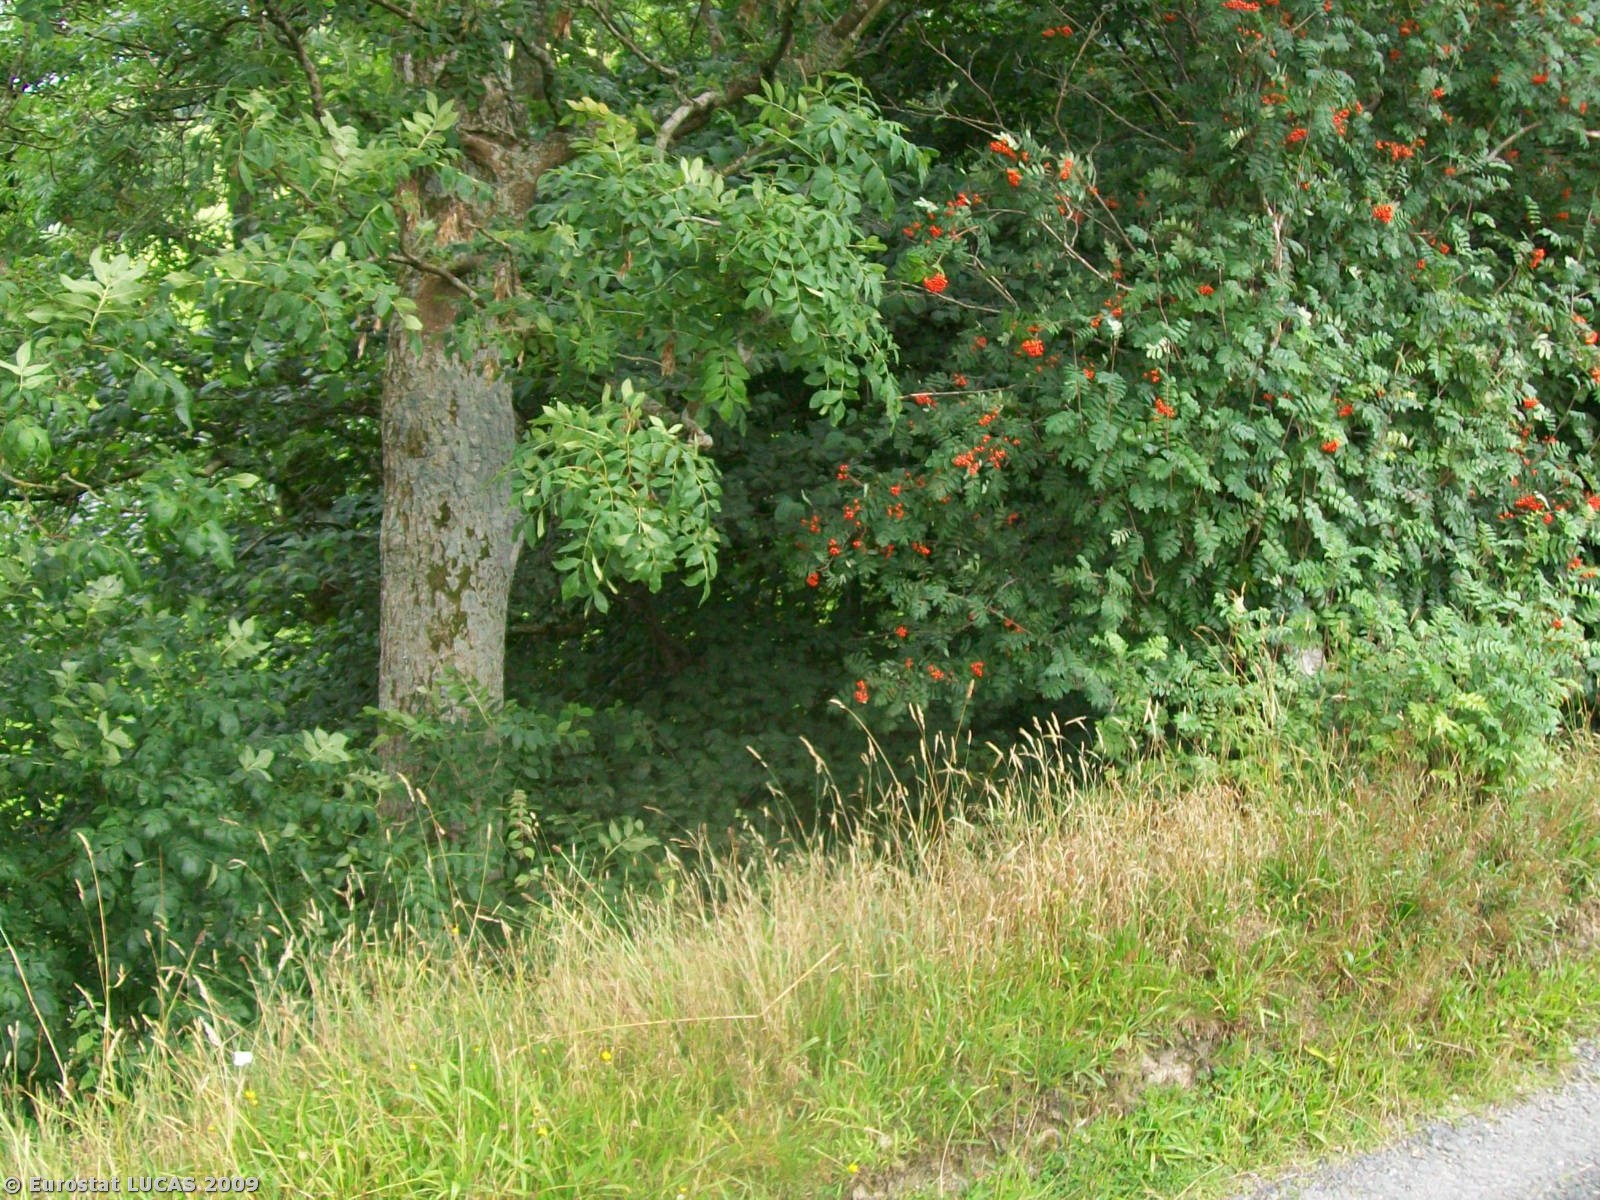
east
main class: Grassland
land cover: Grassland without tree/shrub cover
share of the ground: > 75 %
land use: Agriculture (excluding fallow land and kitchen gardens)
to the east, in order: Grassland without tree/shrub cover; Managed hedges; Grassland without tree/shrub cover; Managed hedges; Grassland without tree/shrub cover
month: August
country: GB
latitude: 52.8034
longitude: -3.3572
